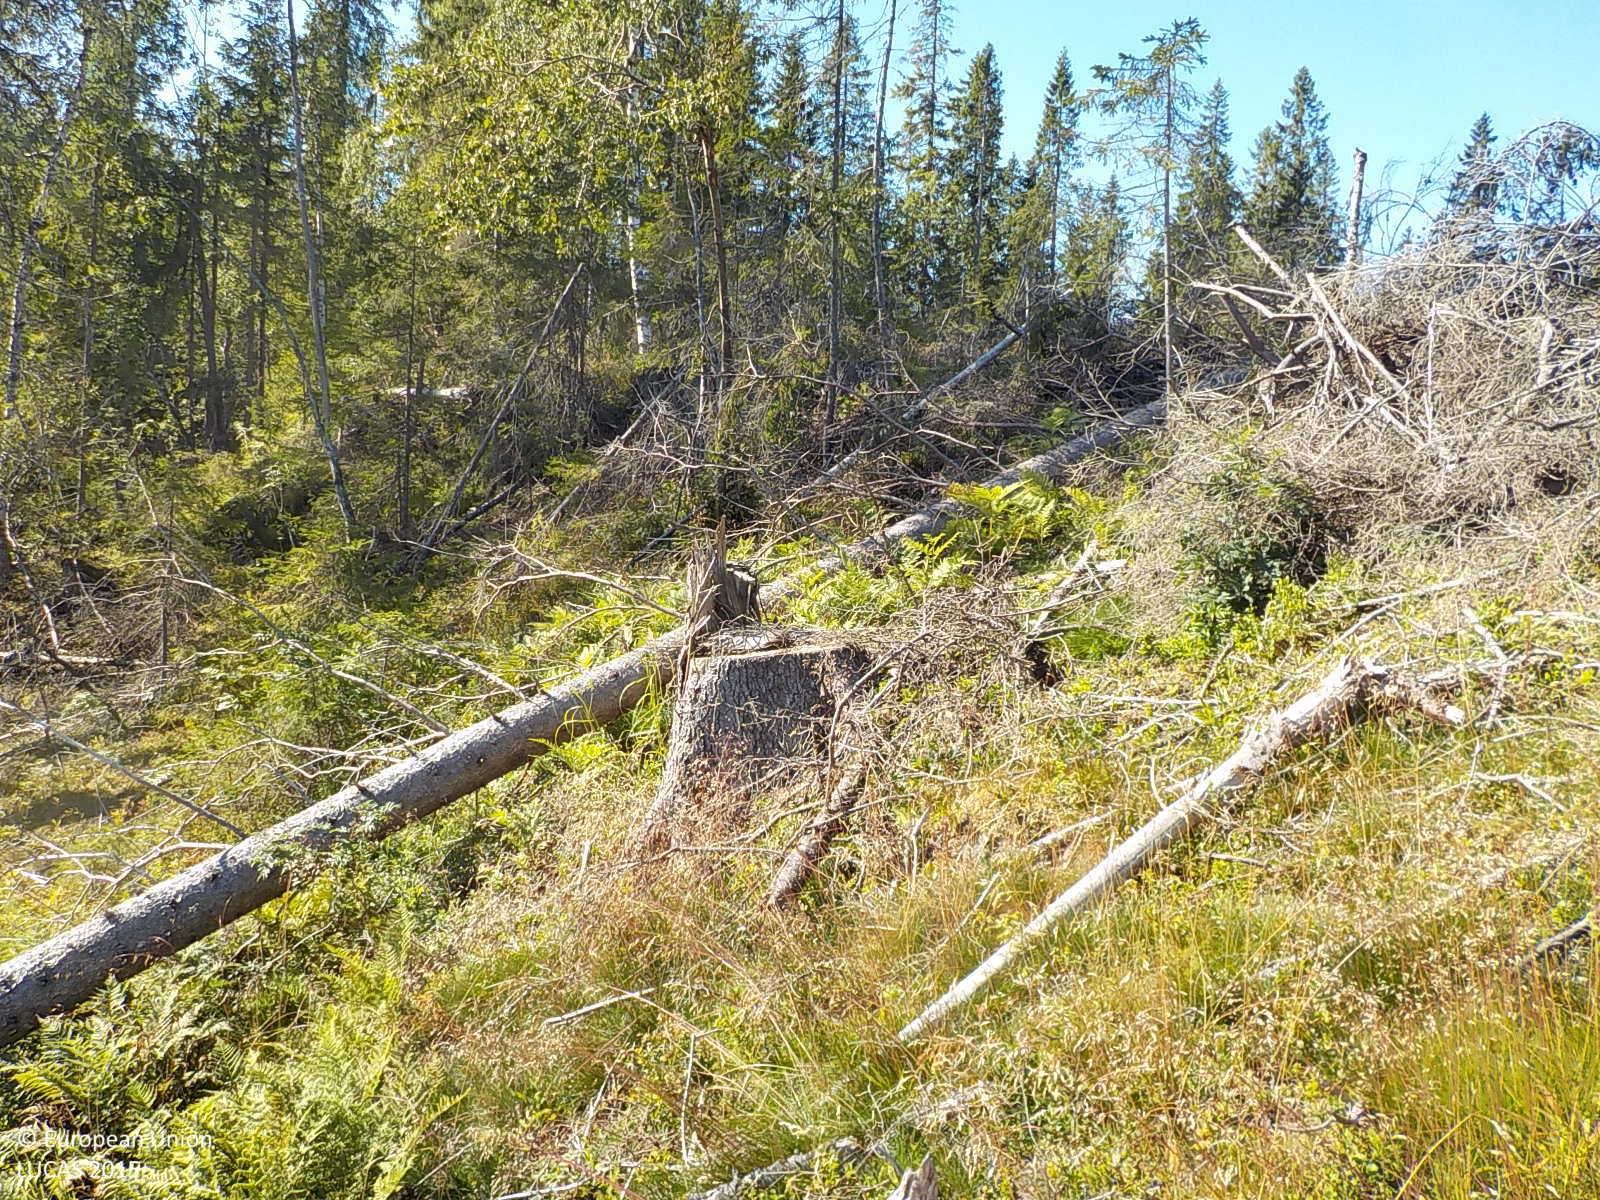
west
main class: Shrubland
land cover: Shrubland with sparse tree cover
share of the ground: > 75 %
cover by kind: shrubs 90 %, coniferous forest trees 5 %, unconsolidated bare surface 5 %
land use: Forestry
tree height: > 5 m
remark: Clear cut
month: August
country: SE
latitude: 63.1058
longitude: 18.3603
